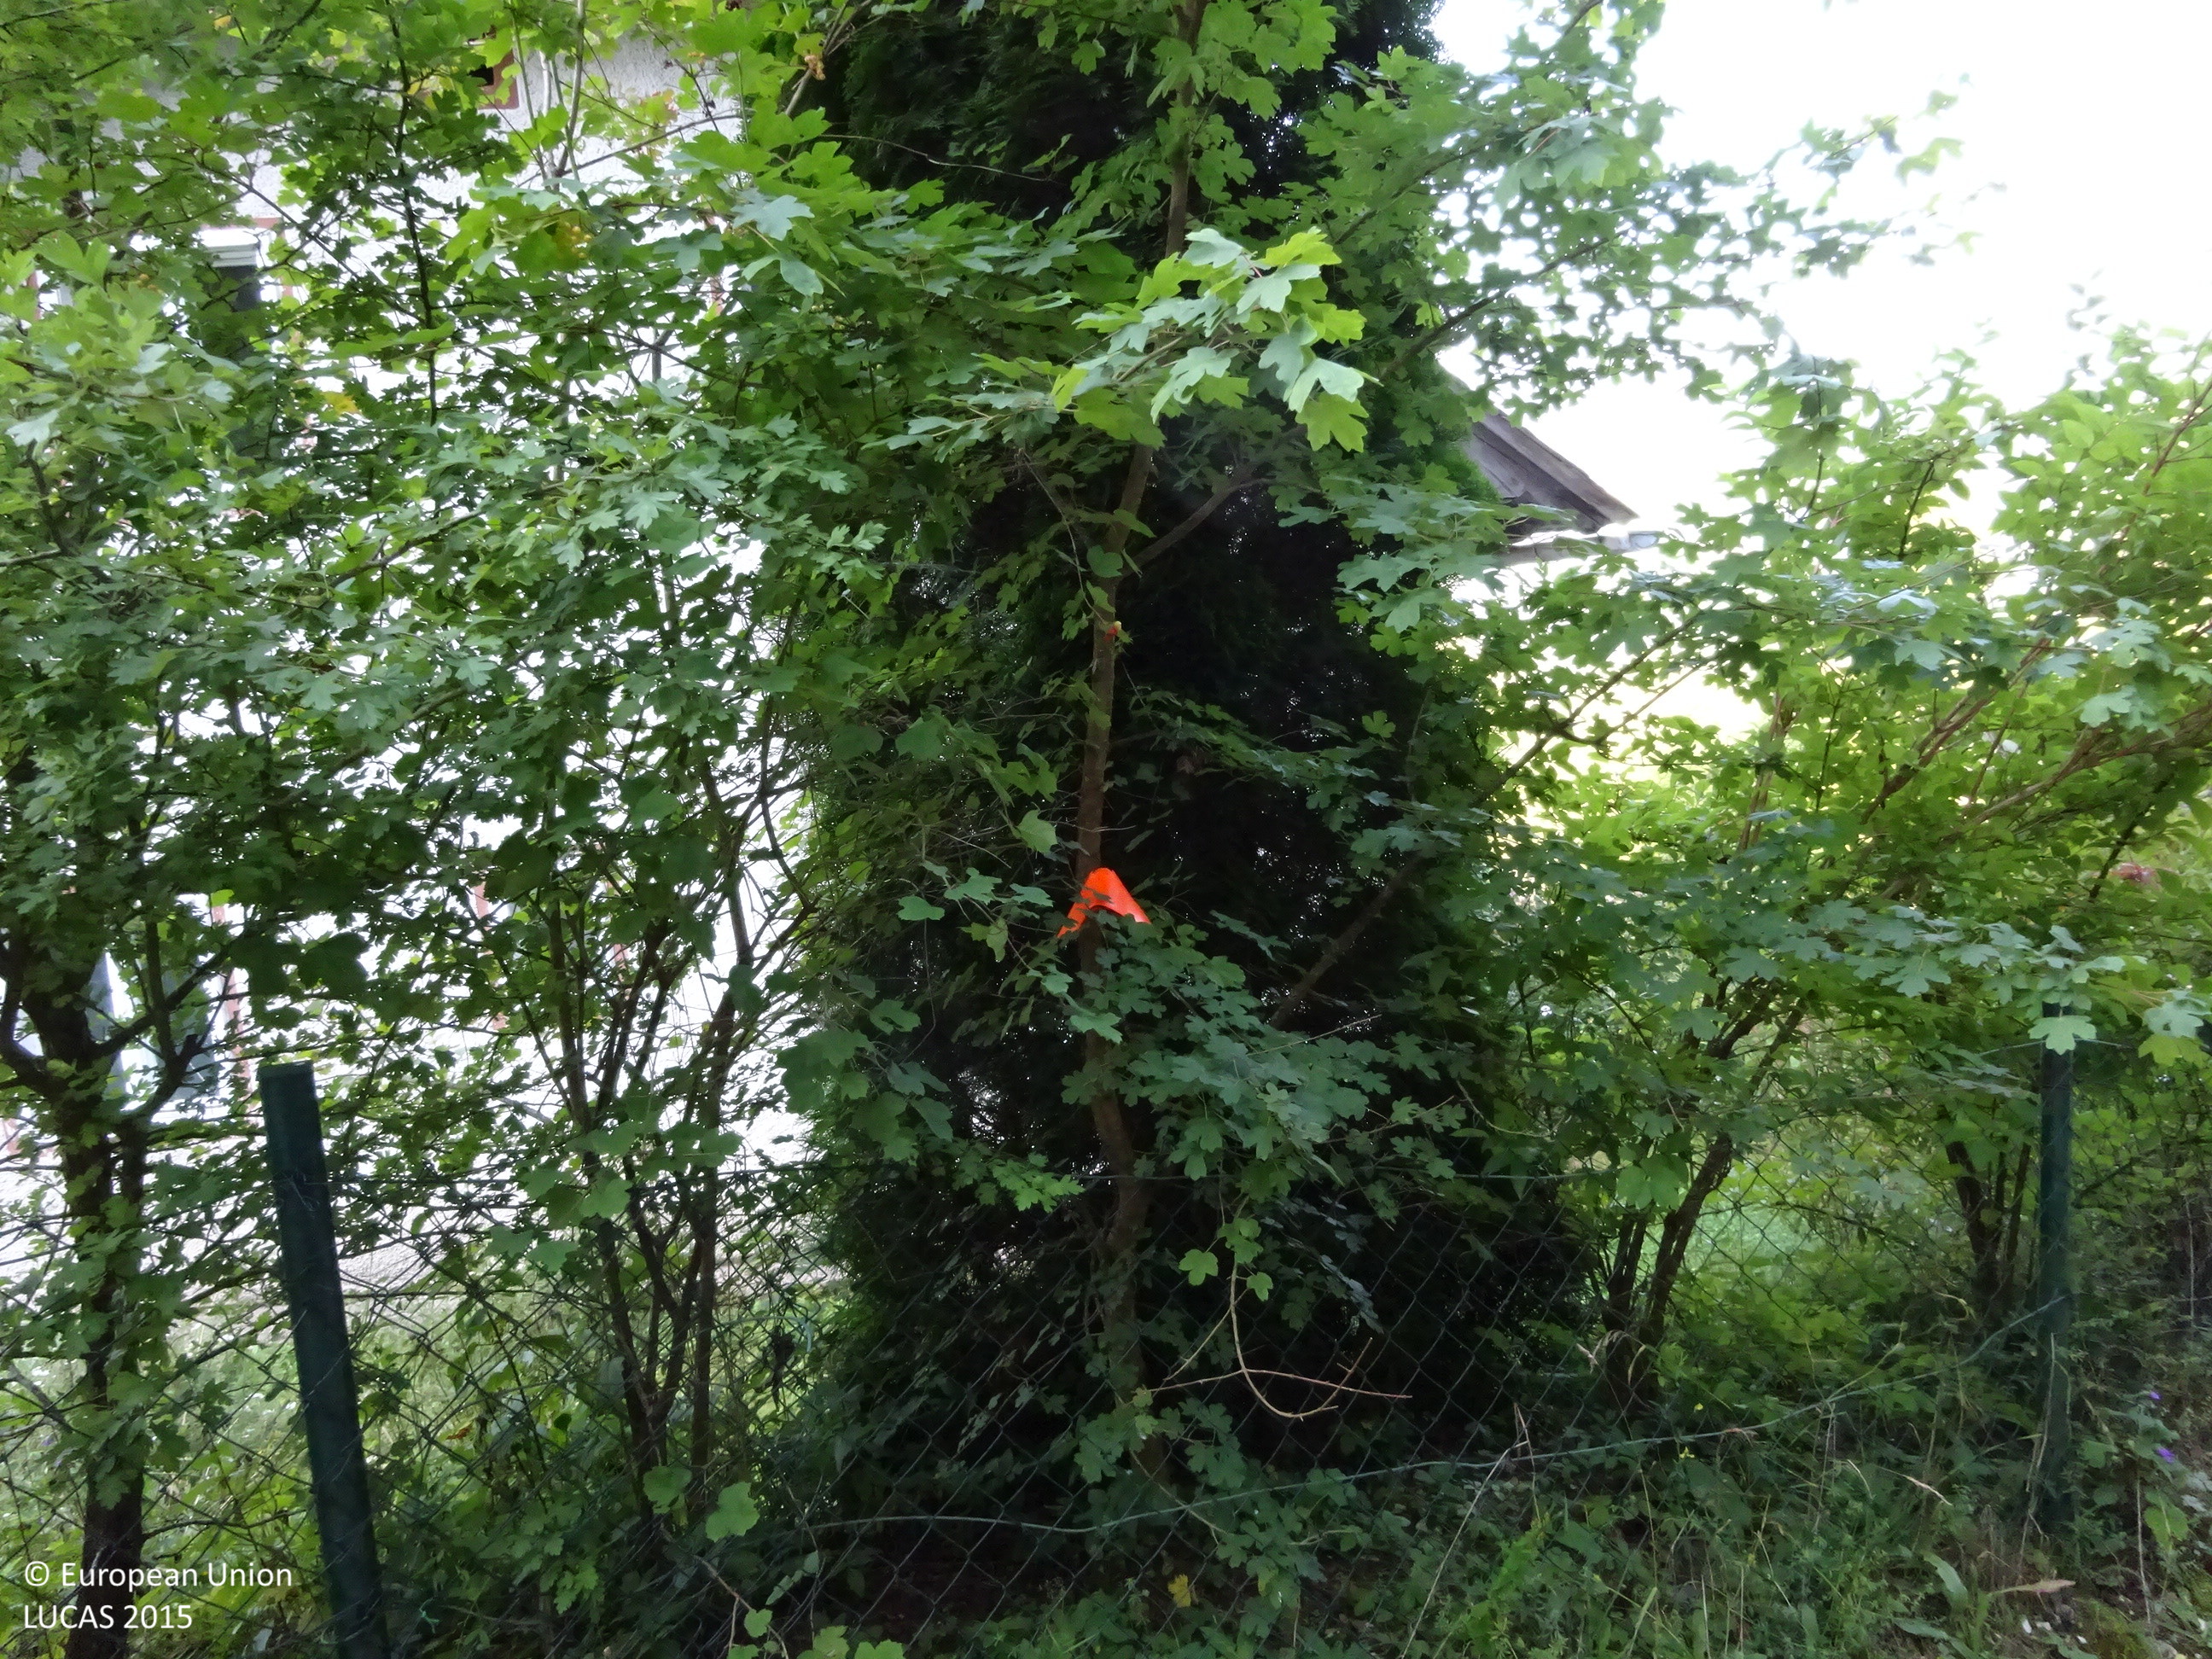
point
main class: Woodland
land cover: Spruce dominated coniferous woodland
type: alpine coniferous forest
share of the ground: 25 - 50 %
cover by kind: herbaceous plants 40 %, coniferous forest trees 25 %, consolidated bare surface 20 %, unconsolidated bare surface 15 %
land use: Forestry
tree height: > 5 m
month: August
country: AT
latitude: 47.4354
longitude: 15.5298
